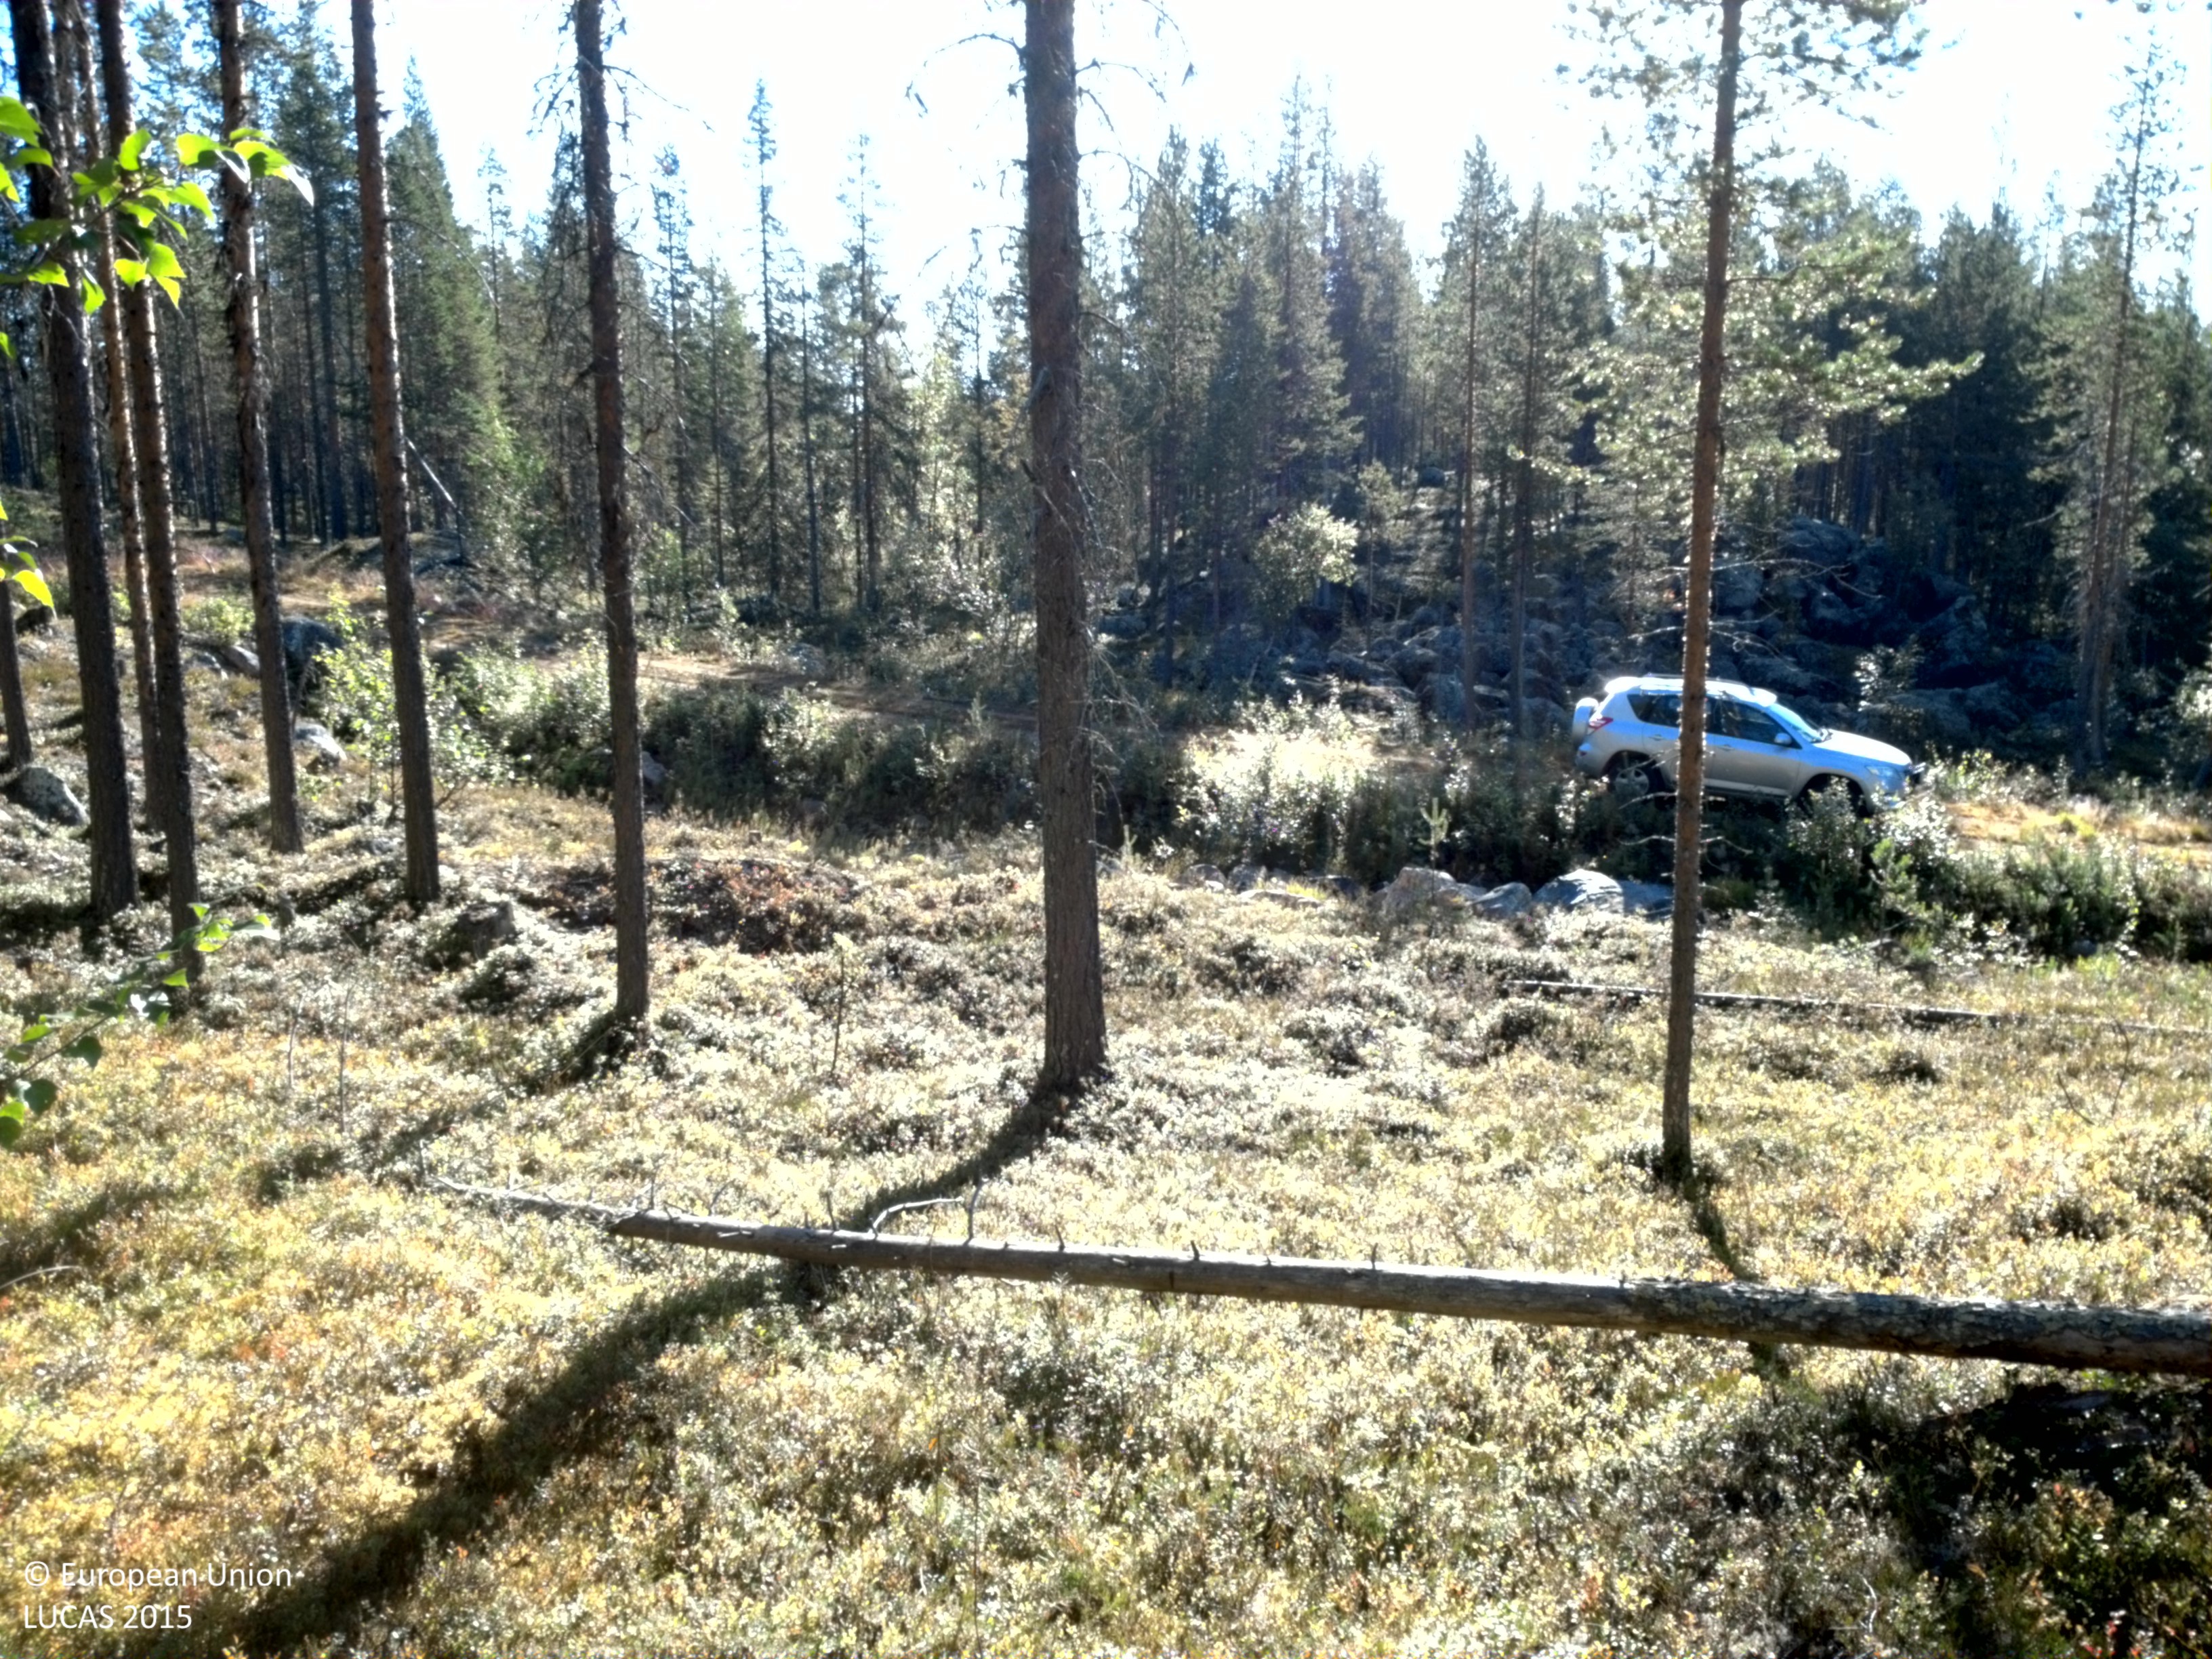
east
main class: Woodland
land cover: Pine dominated coniferous woodland
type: boreal forest
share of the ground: 25 - 50 %
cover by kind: shrubs 60 %, coniferous forest trees 35 %, consolidated bare surface 5 %
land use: Forestry
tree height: > 5 m
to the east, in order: Pine dominated coniferous woodland; Shrubland with sparse tree cover; Rocks and stones; Abandoned hedges; Tracks; Broadleaved woodland; Pine dominated coniferous woodland
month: August
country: SE
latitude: 66.6799
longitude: 19.5716
